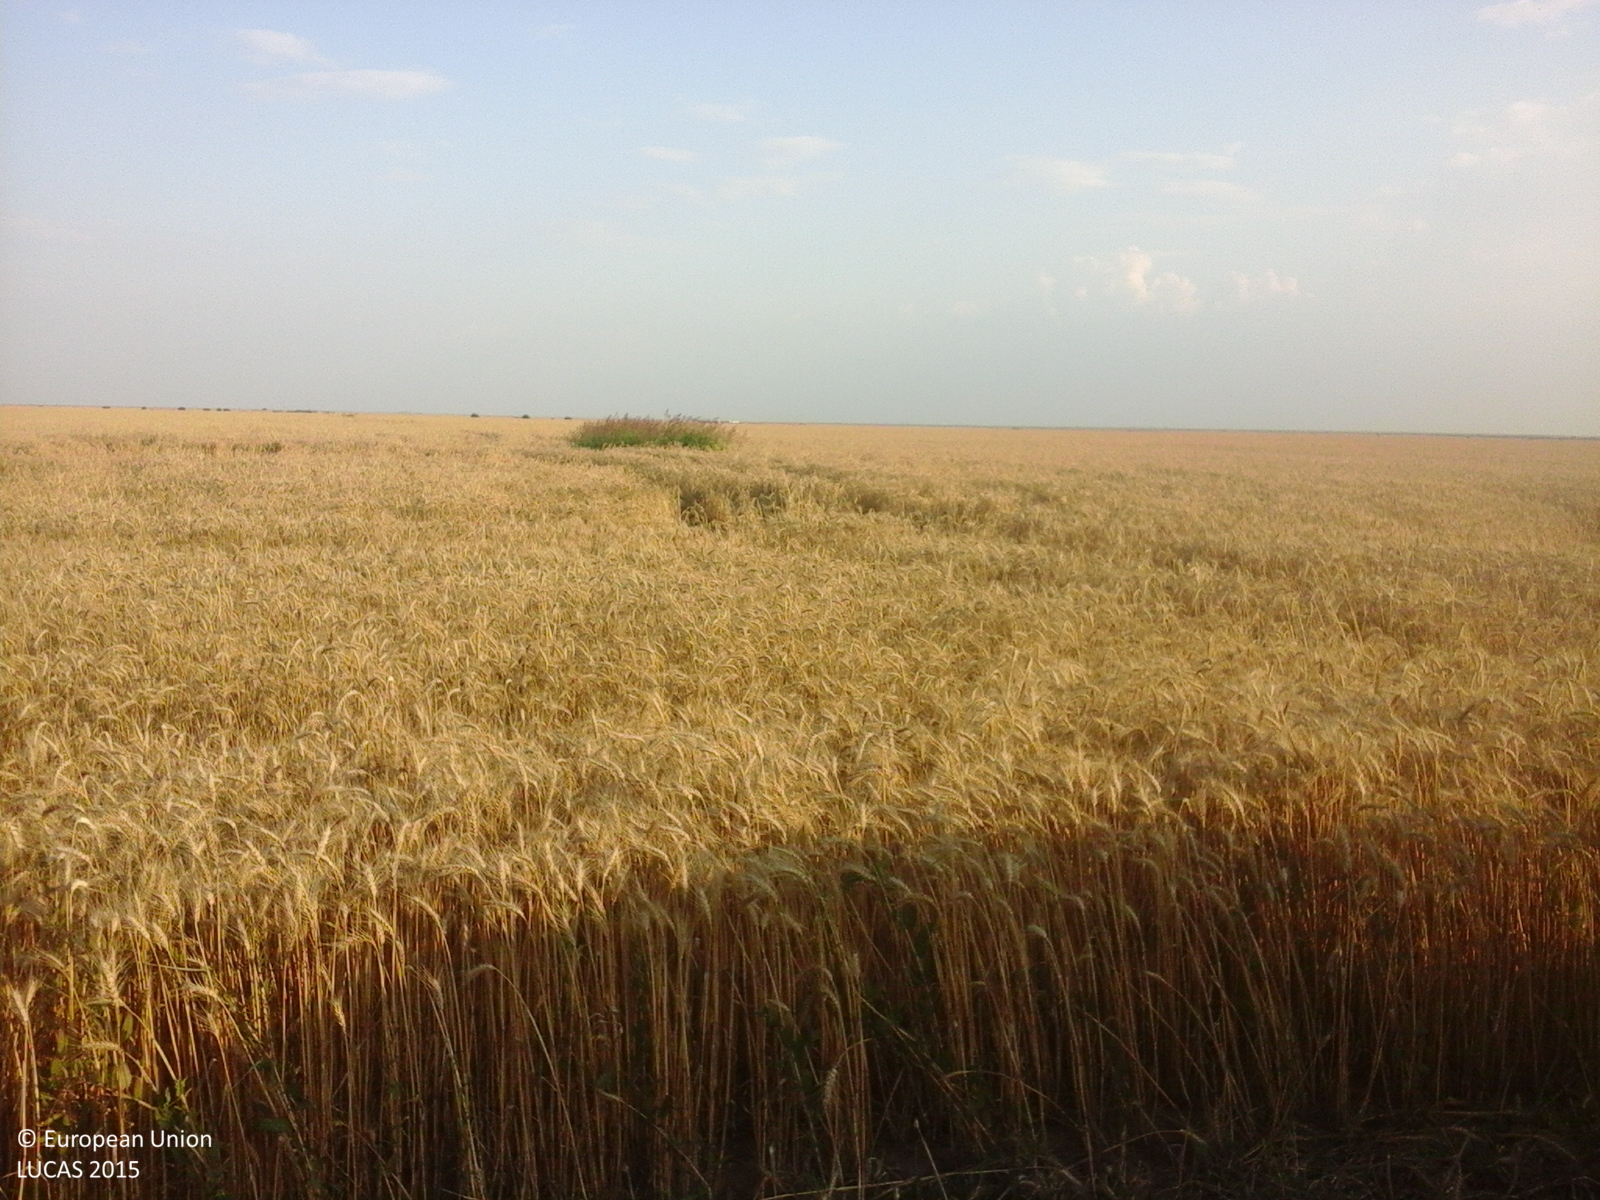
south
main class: Cropland
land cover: Common wheat
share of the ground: > 75 %
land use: Agriculture (excluding fallow land and kitchen gardens)
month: July
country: RO
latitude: 43.9261
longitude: 24.7810
